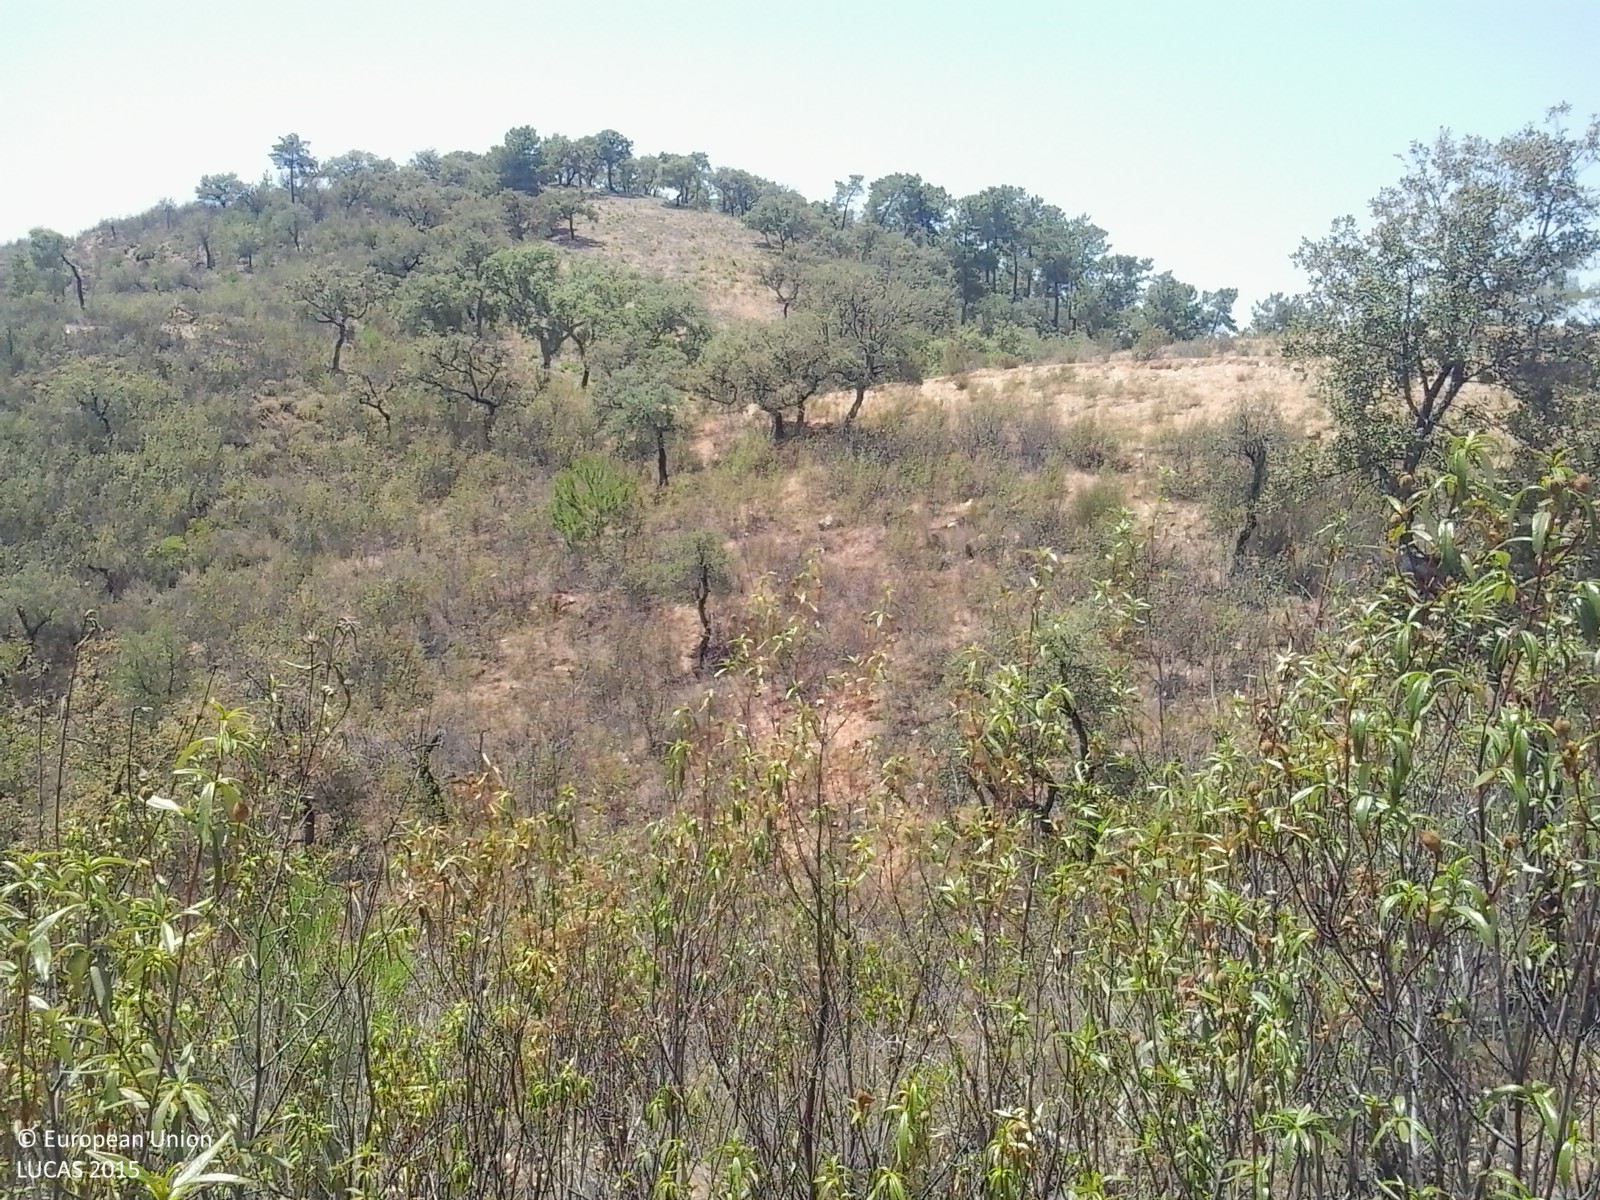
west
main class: Shrubland
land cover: Shrubland with sparse tree cover
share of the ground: > 75 %
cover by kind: shrubs 85 %, herbaceous plants 10 %, broadleaved forest trees 5 %
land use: Forestry
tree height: < 5 m
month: July
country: ES
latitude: 37.5651
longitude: -6.4164
